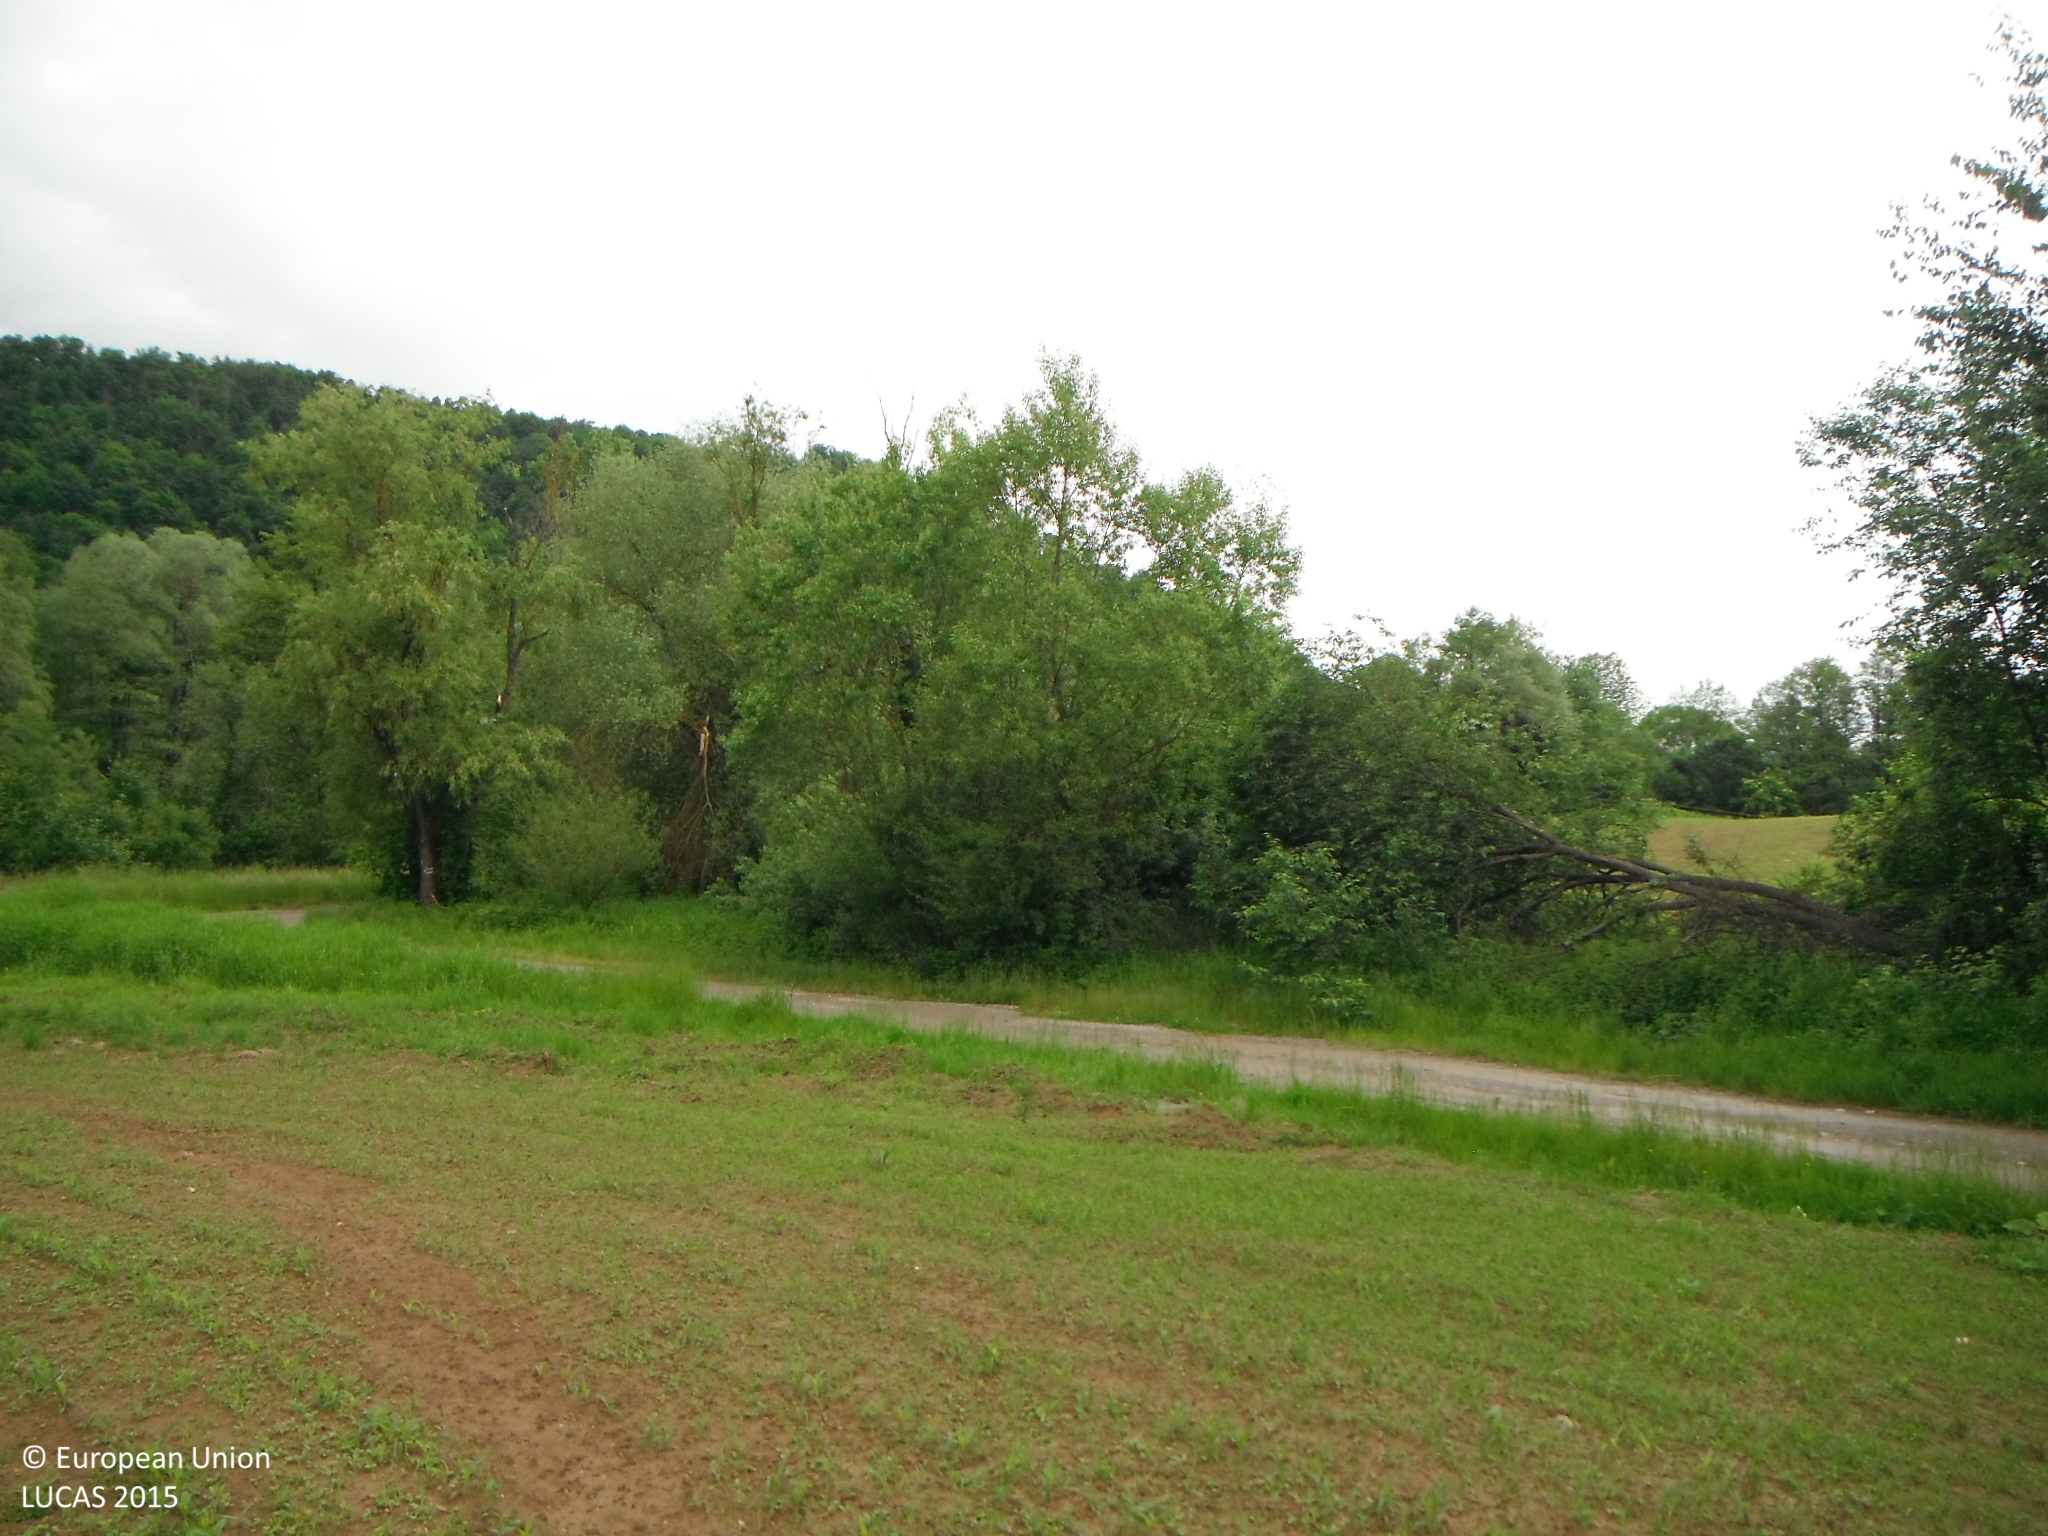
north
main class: Cropland
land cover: Maize
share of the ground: < 10 %
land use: Agriculture (excluding fallow land and kitchen gardens)
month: May
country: SK
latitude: 48.7411
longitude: 19.2291
